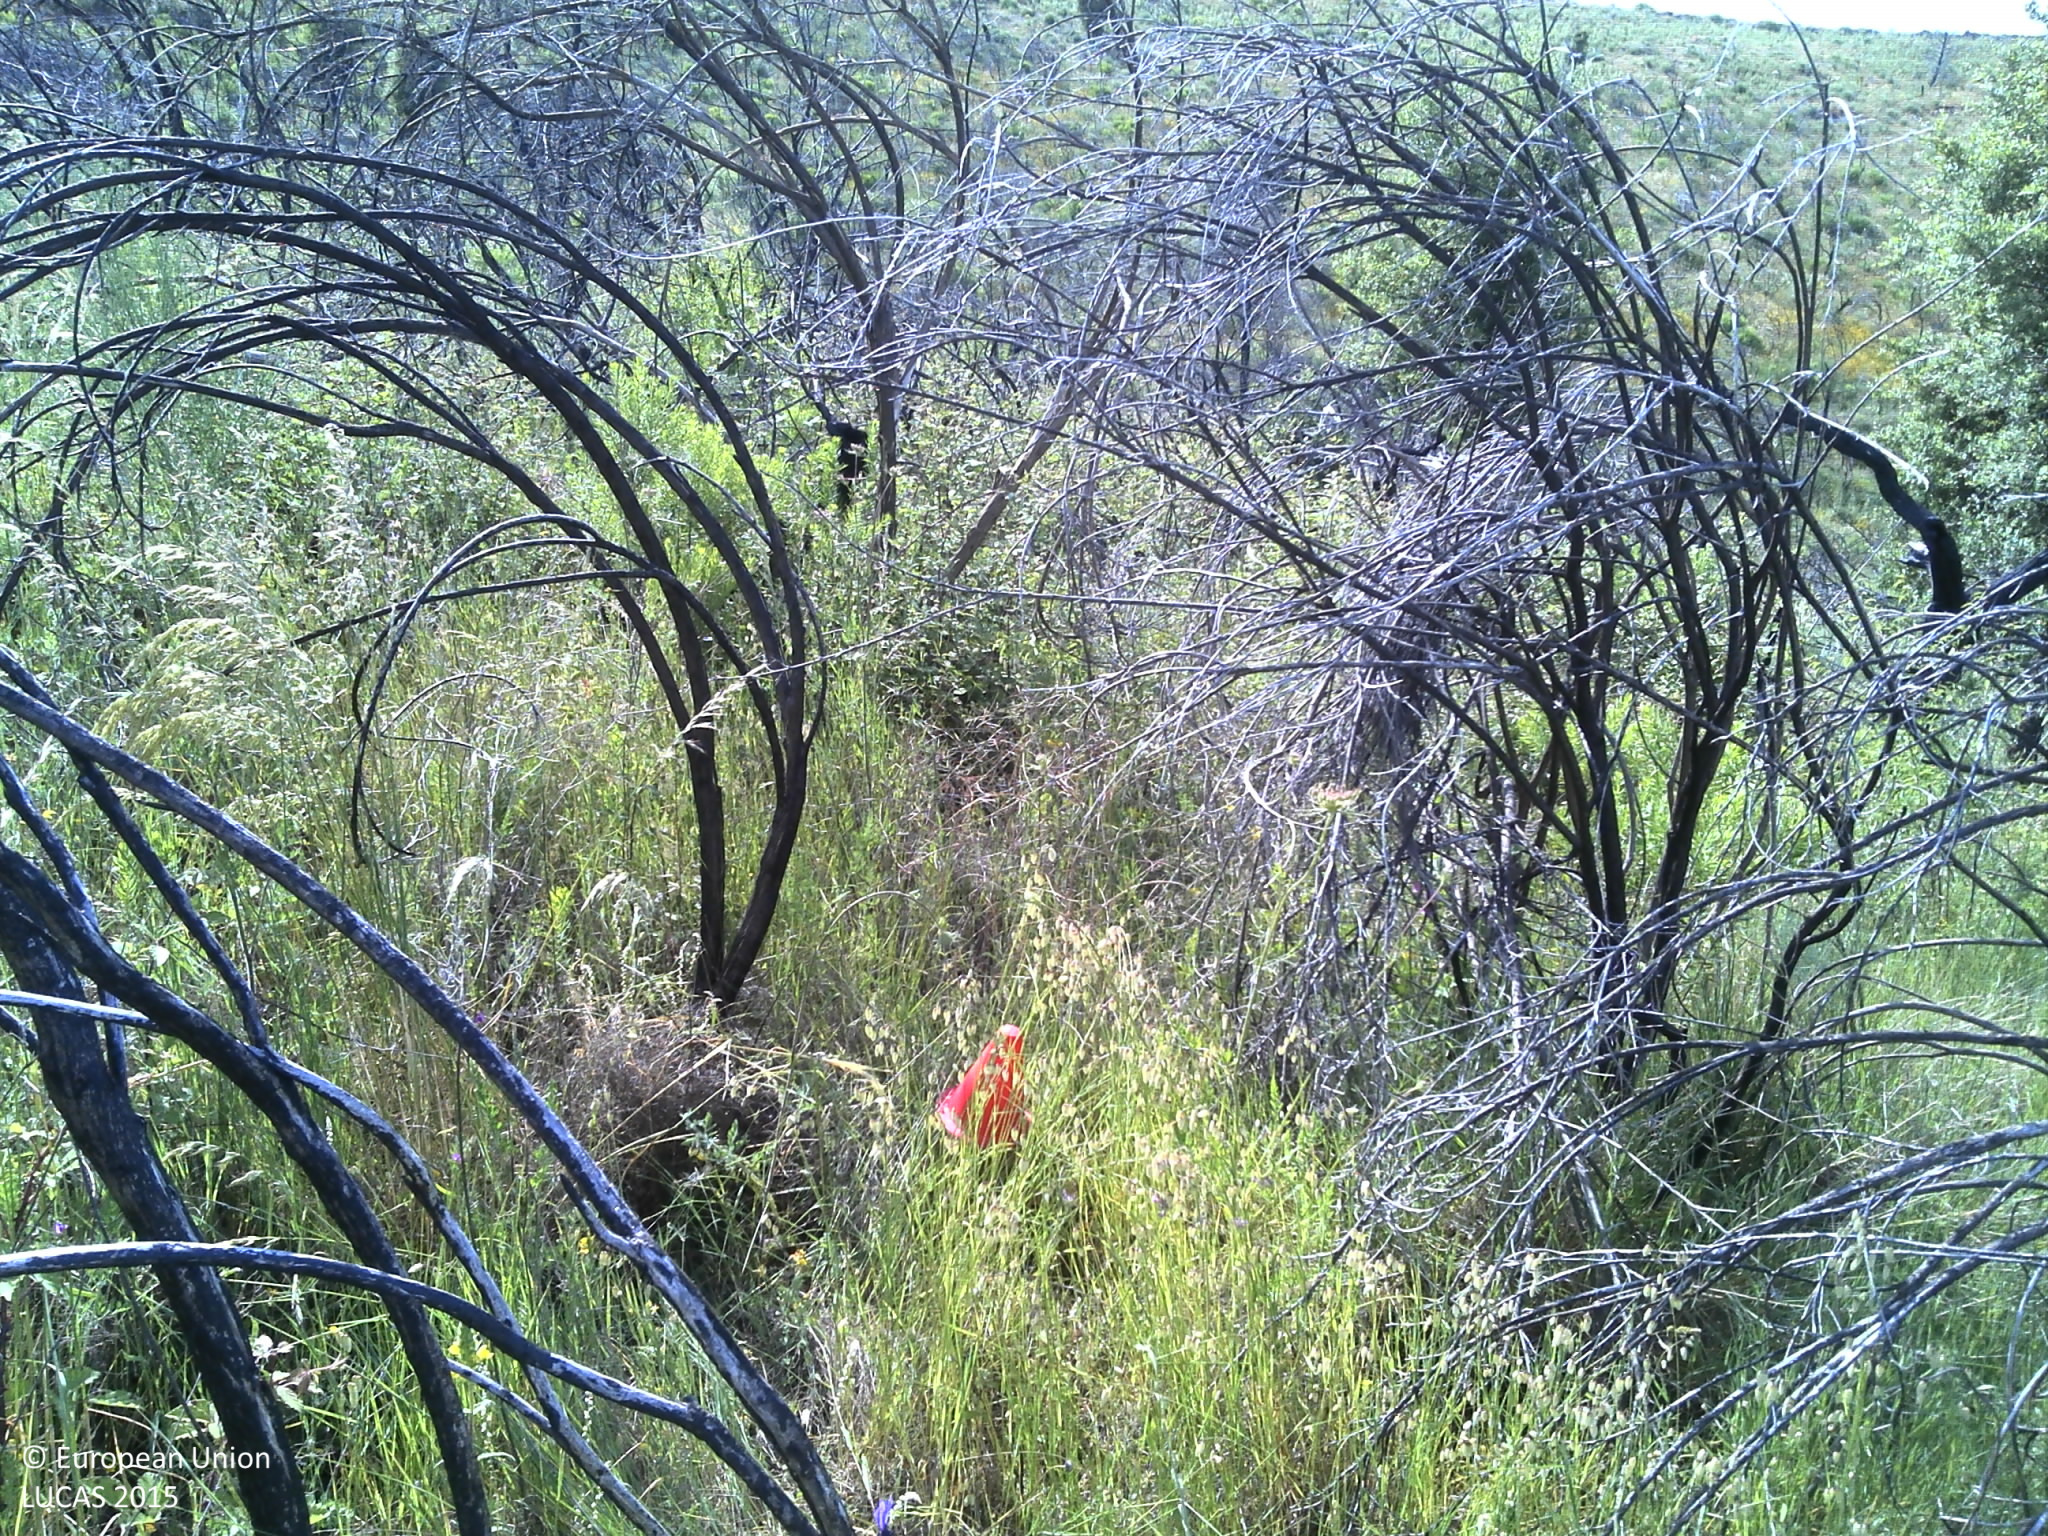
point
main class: Shrubland
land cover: Shrubland with sparse tree cover
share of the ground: 10 - 25 %
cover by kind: herbaceous plants 75 %, shrubs 20 %, broadleaved forest trees 5 %
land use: Abandoned areas
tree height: > 5 m
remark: Burnt area
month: May
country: PT
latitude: 41.2272
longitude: -6.8682
